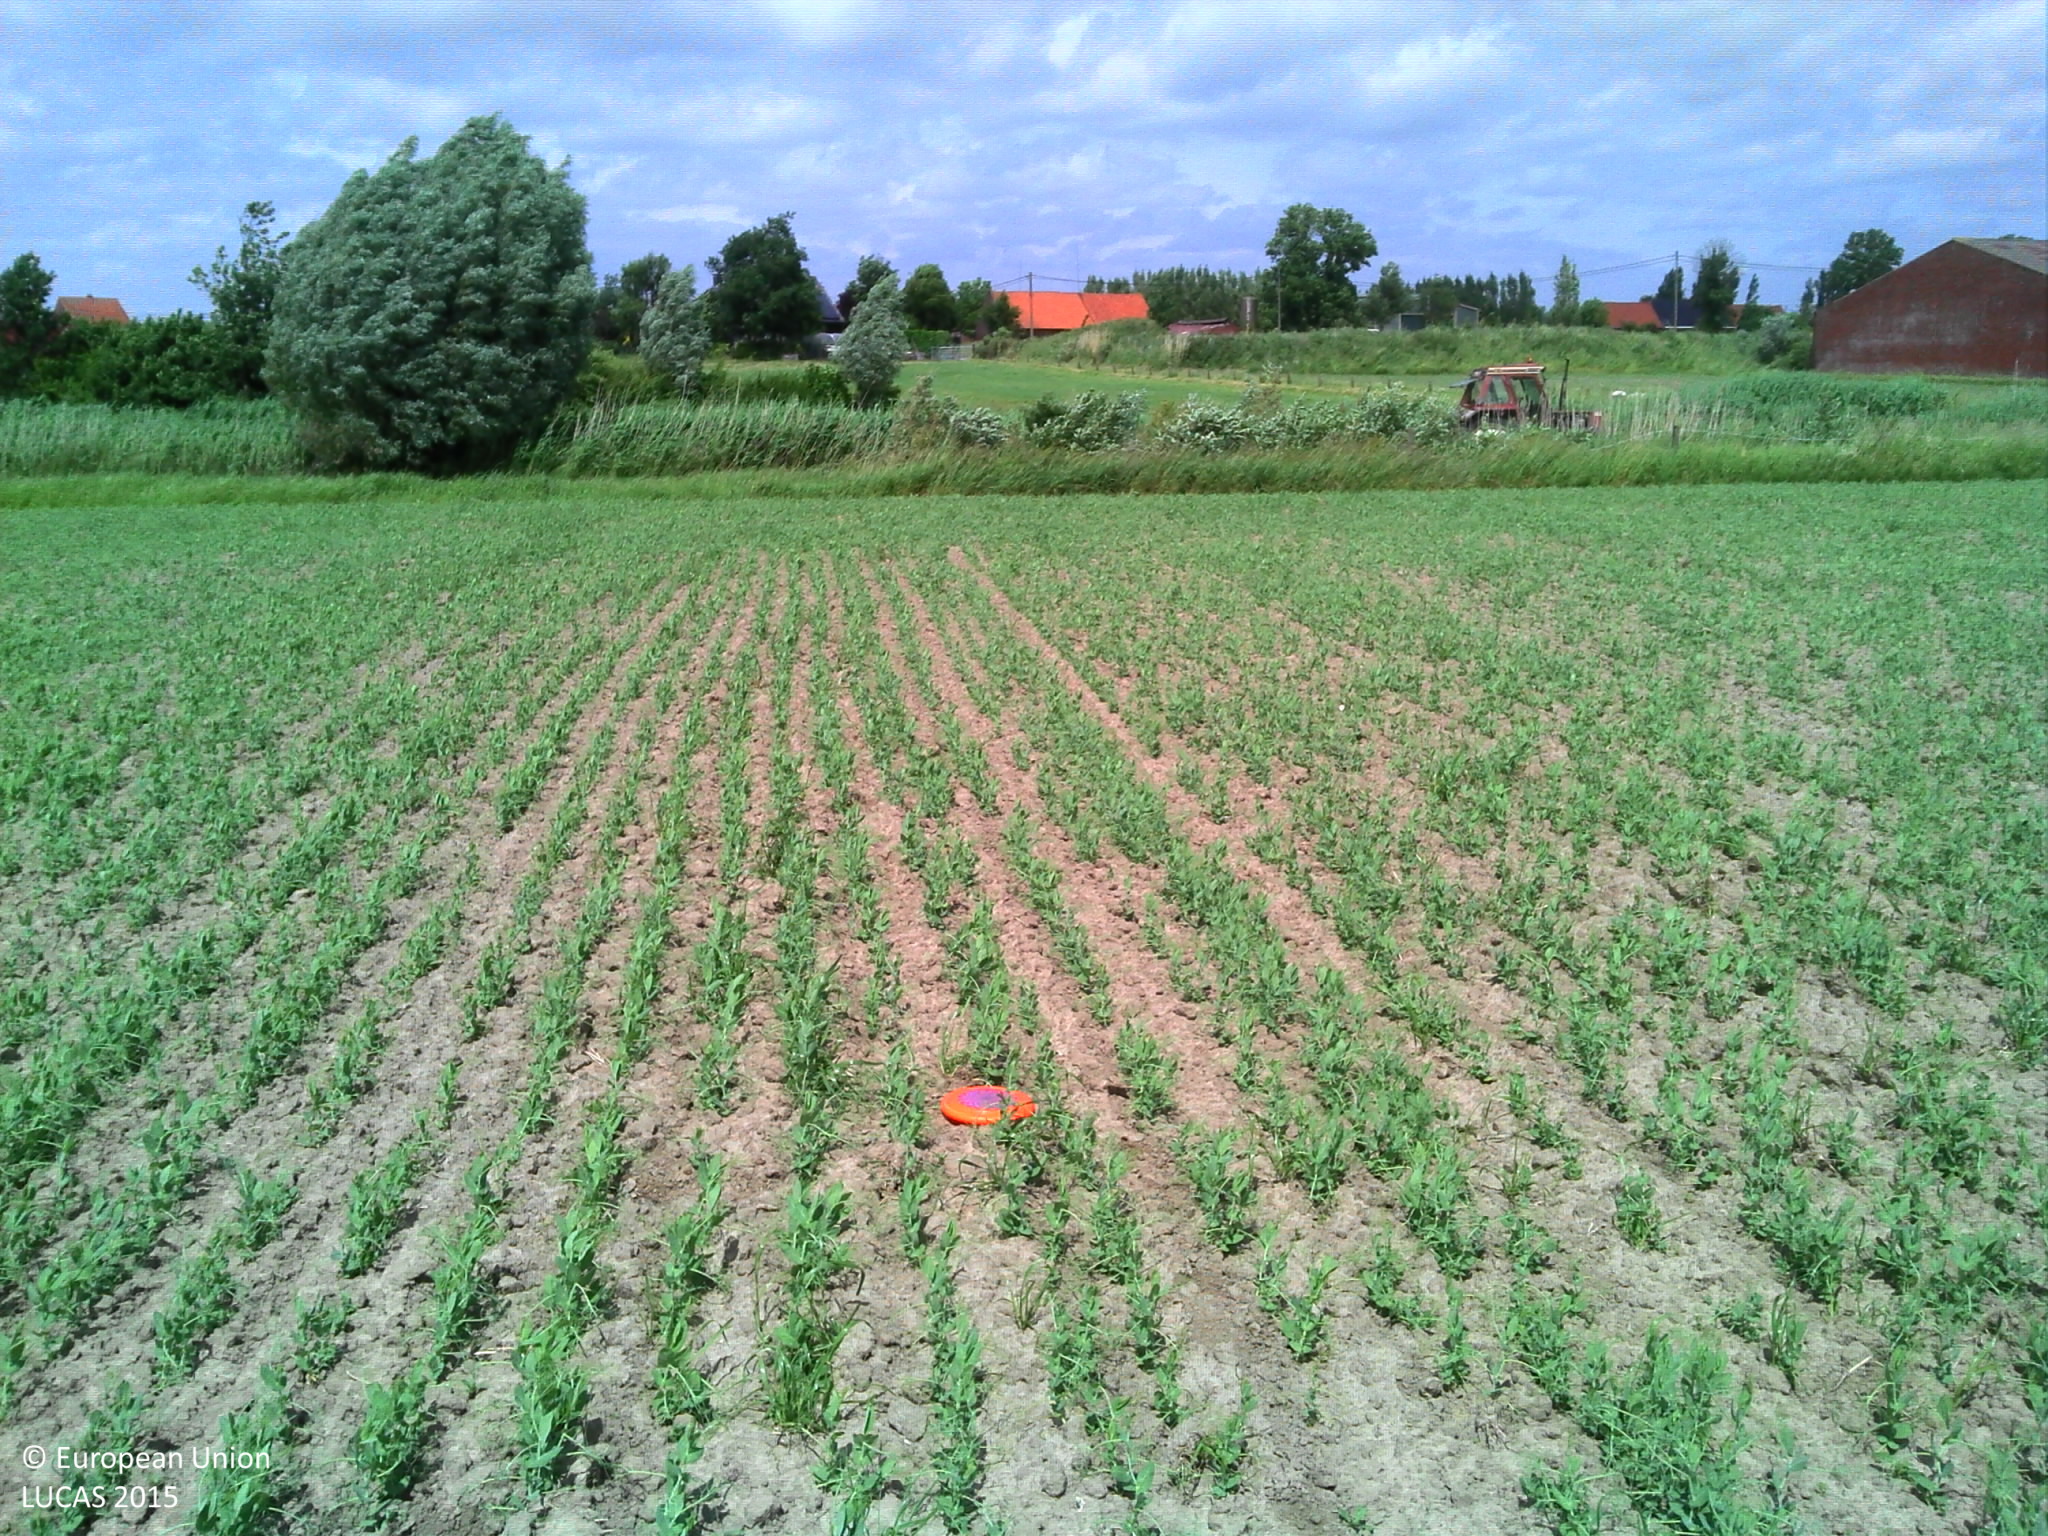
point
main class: Cropland
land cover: Dry pulses
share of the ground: 50 - 75 %
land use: Agriculture (excluding fallow land and kitchen gardens)
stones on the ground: < 10 %
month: June
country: BE
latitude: 51.0221
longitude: 3.1045
